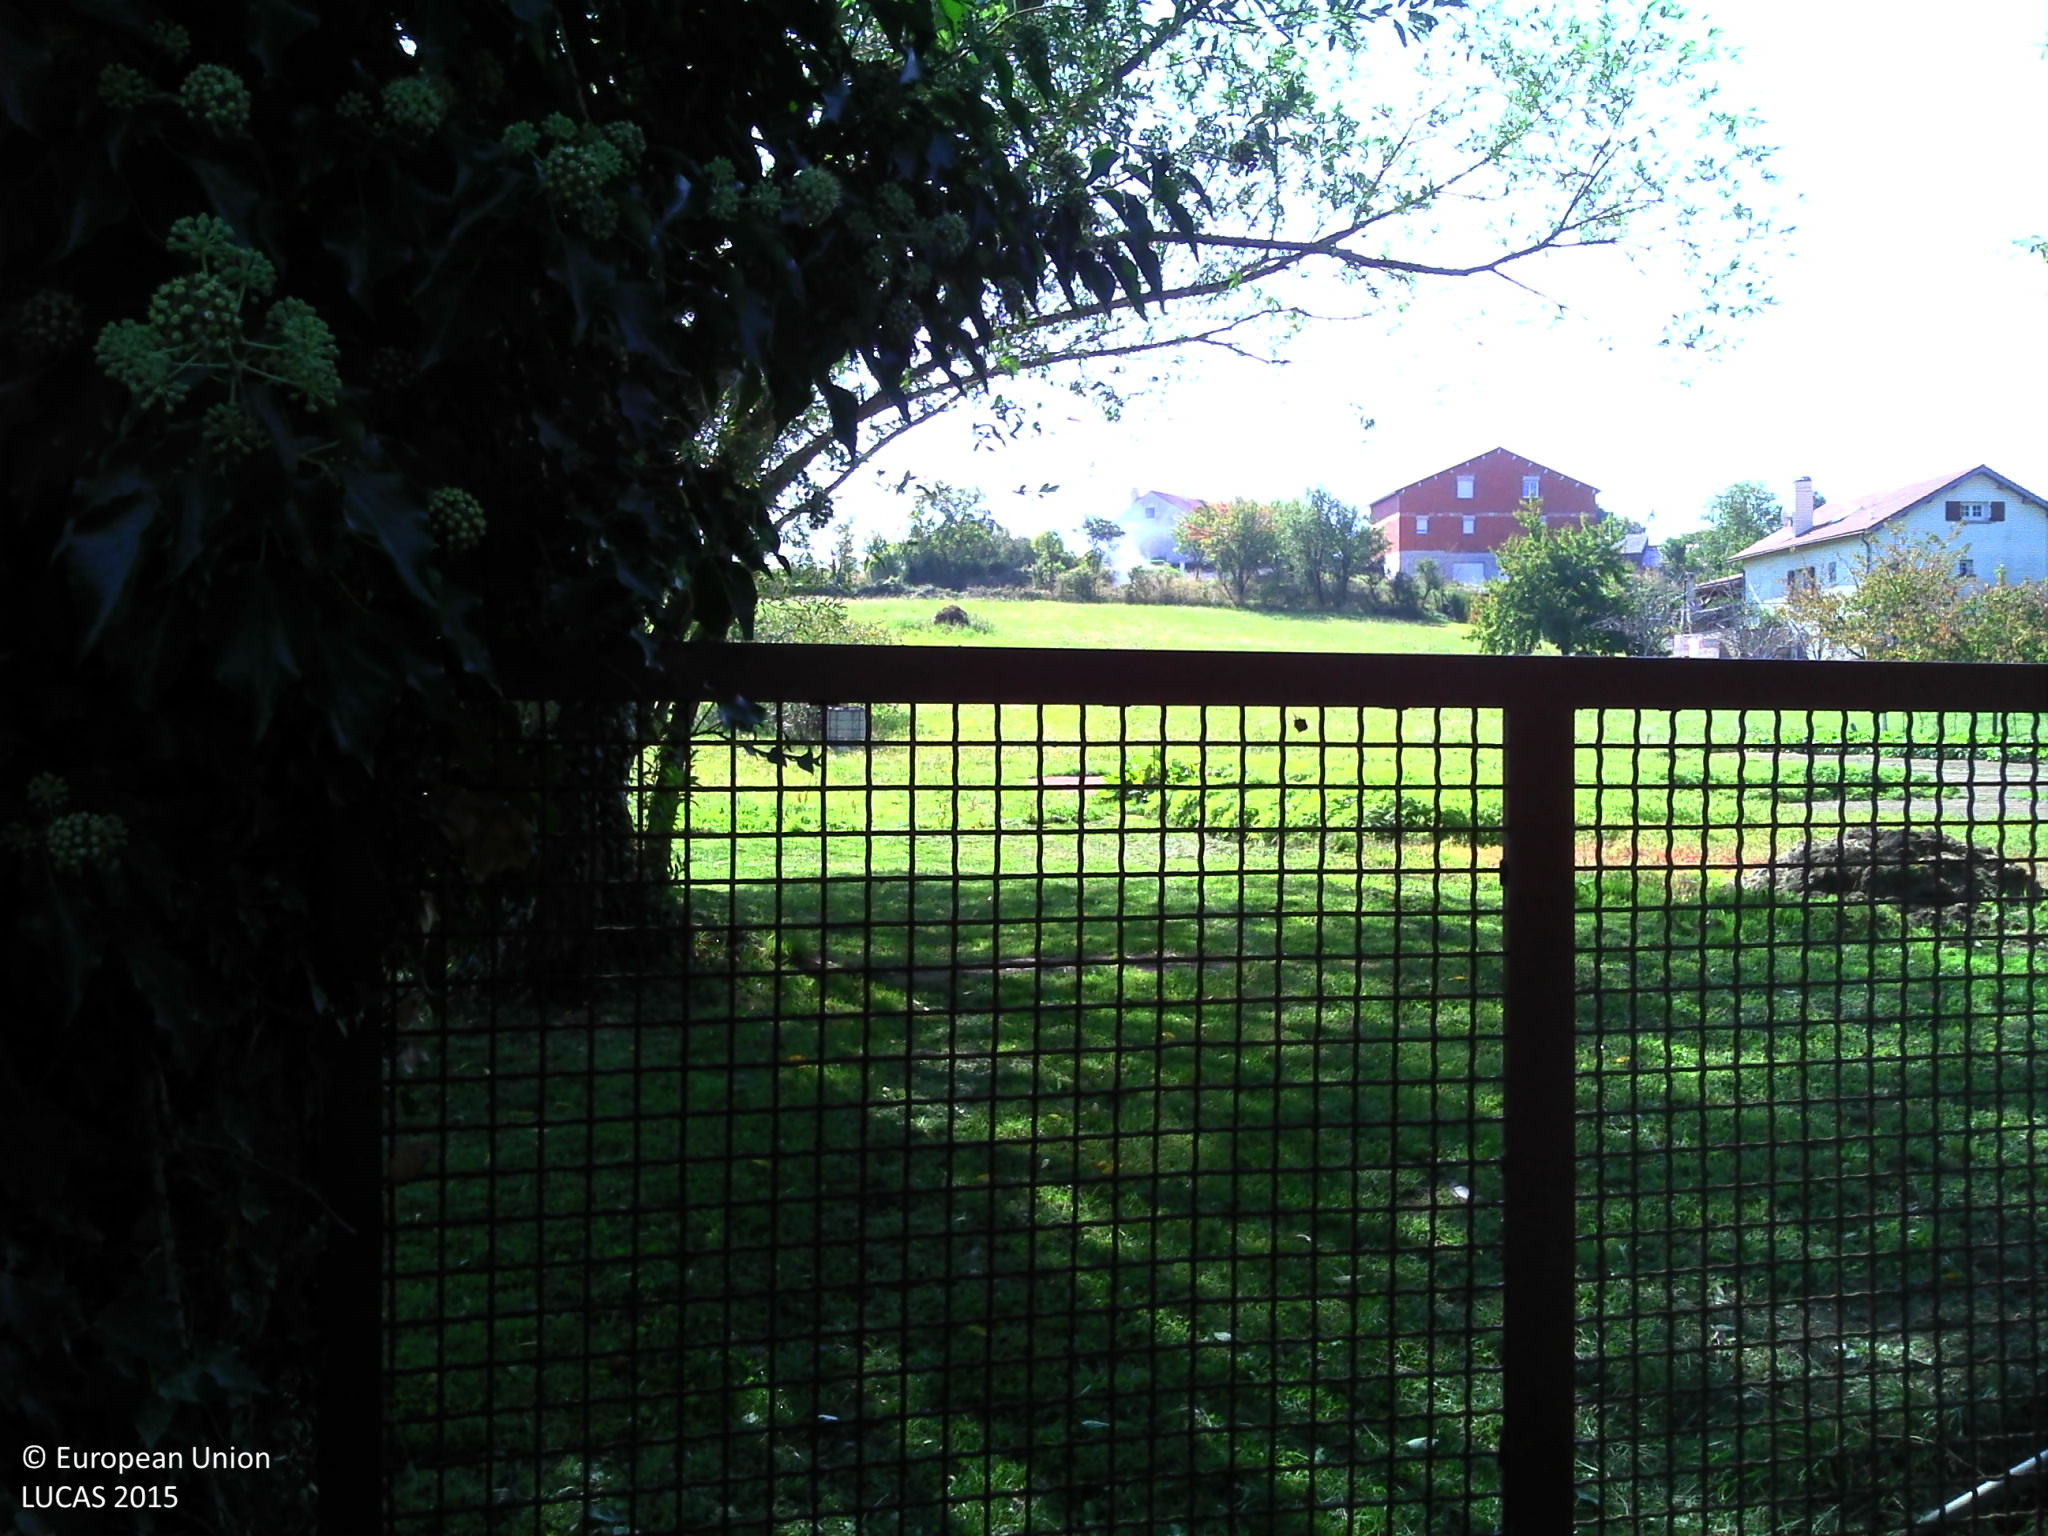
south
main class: Grassland
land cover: Grassland without tree/shrub cover
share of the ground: > 75 %
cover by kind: herbaceous plants 100 %
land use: Agriculture (excluding fallow land and kitchen gardens)
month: October
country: FR
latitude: 45.8902
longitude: 3.0531
